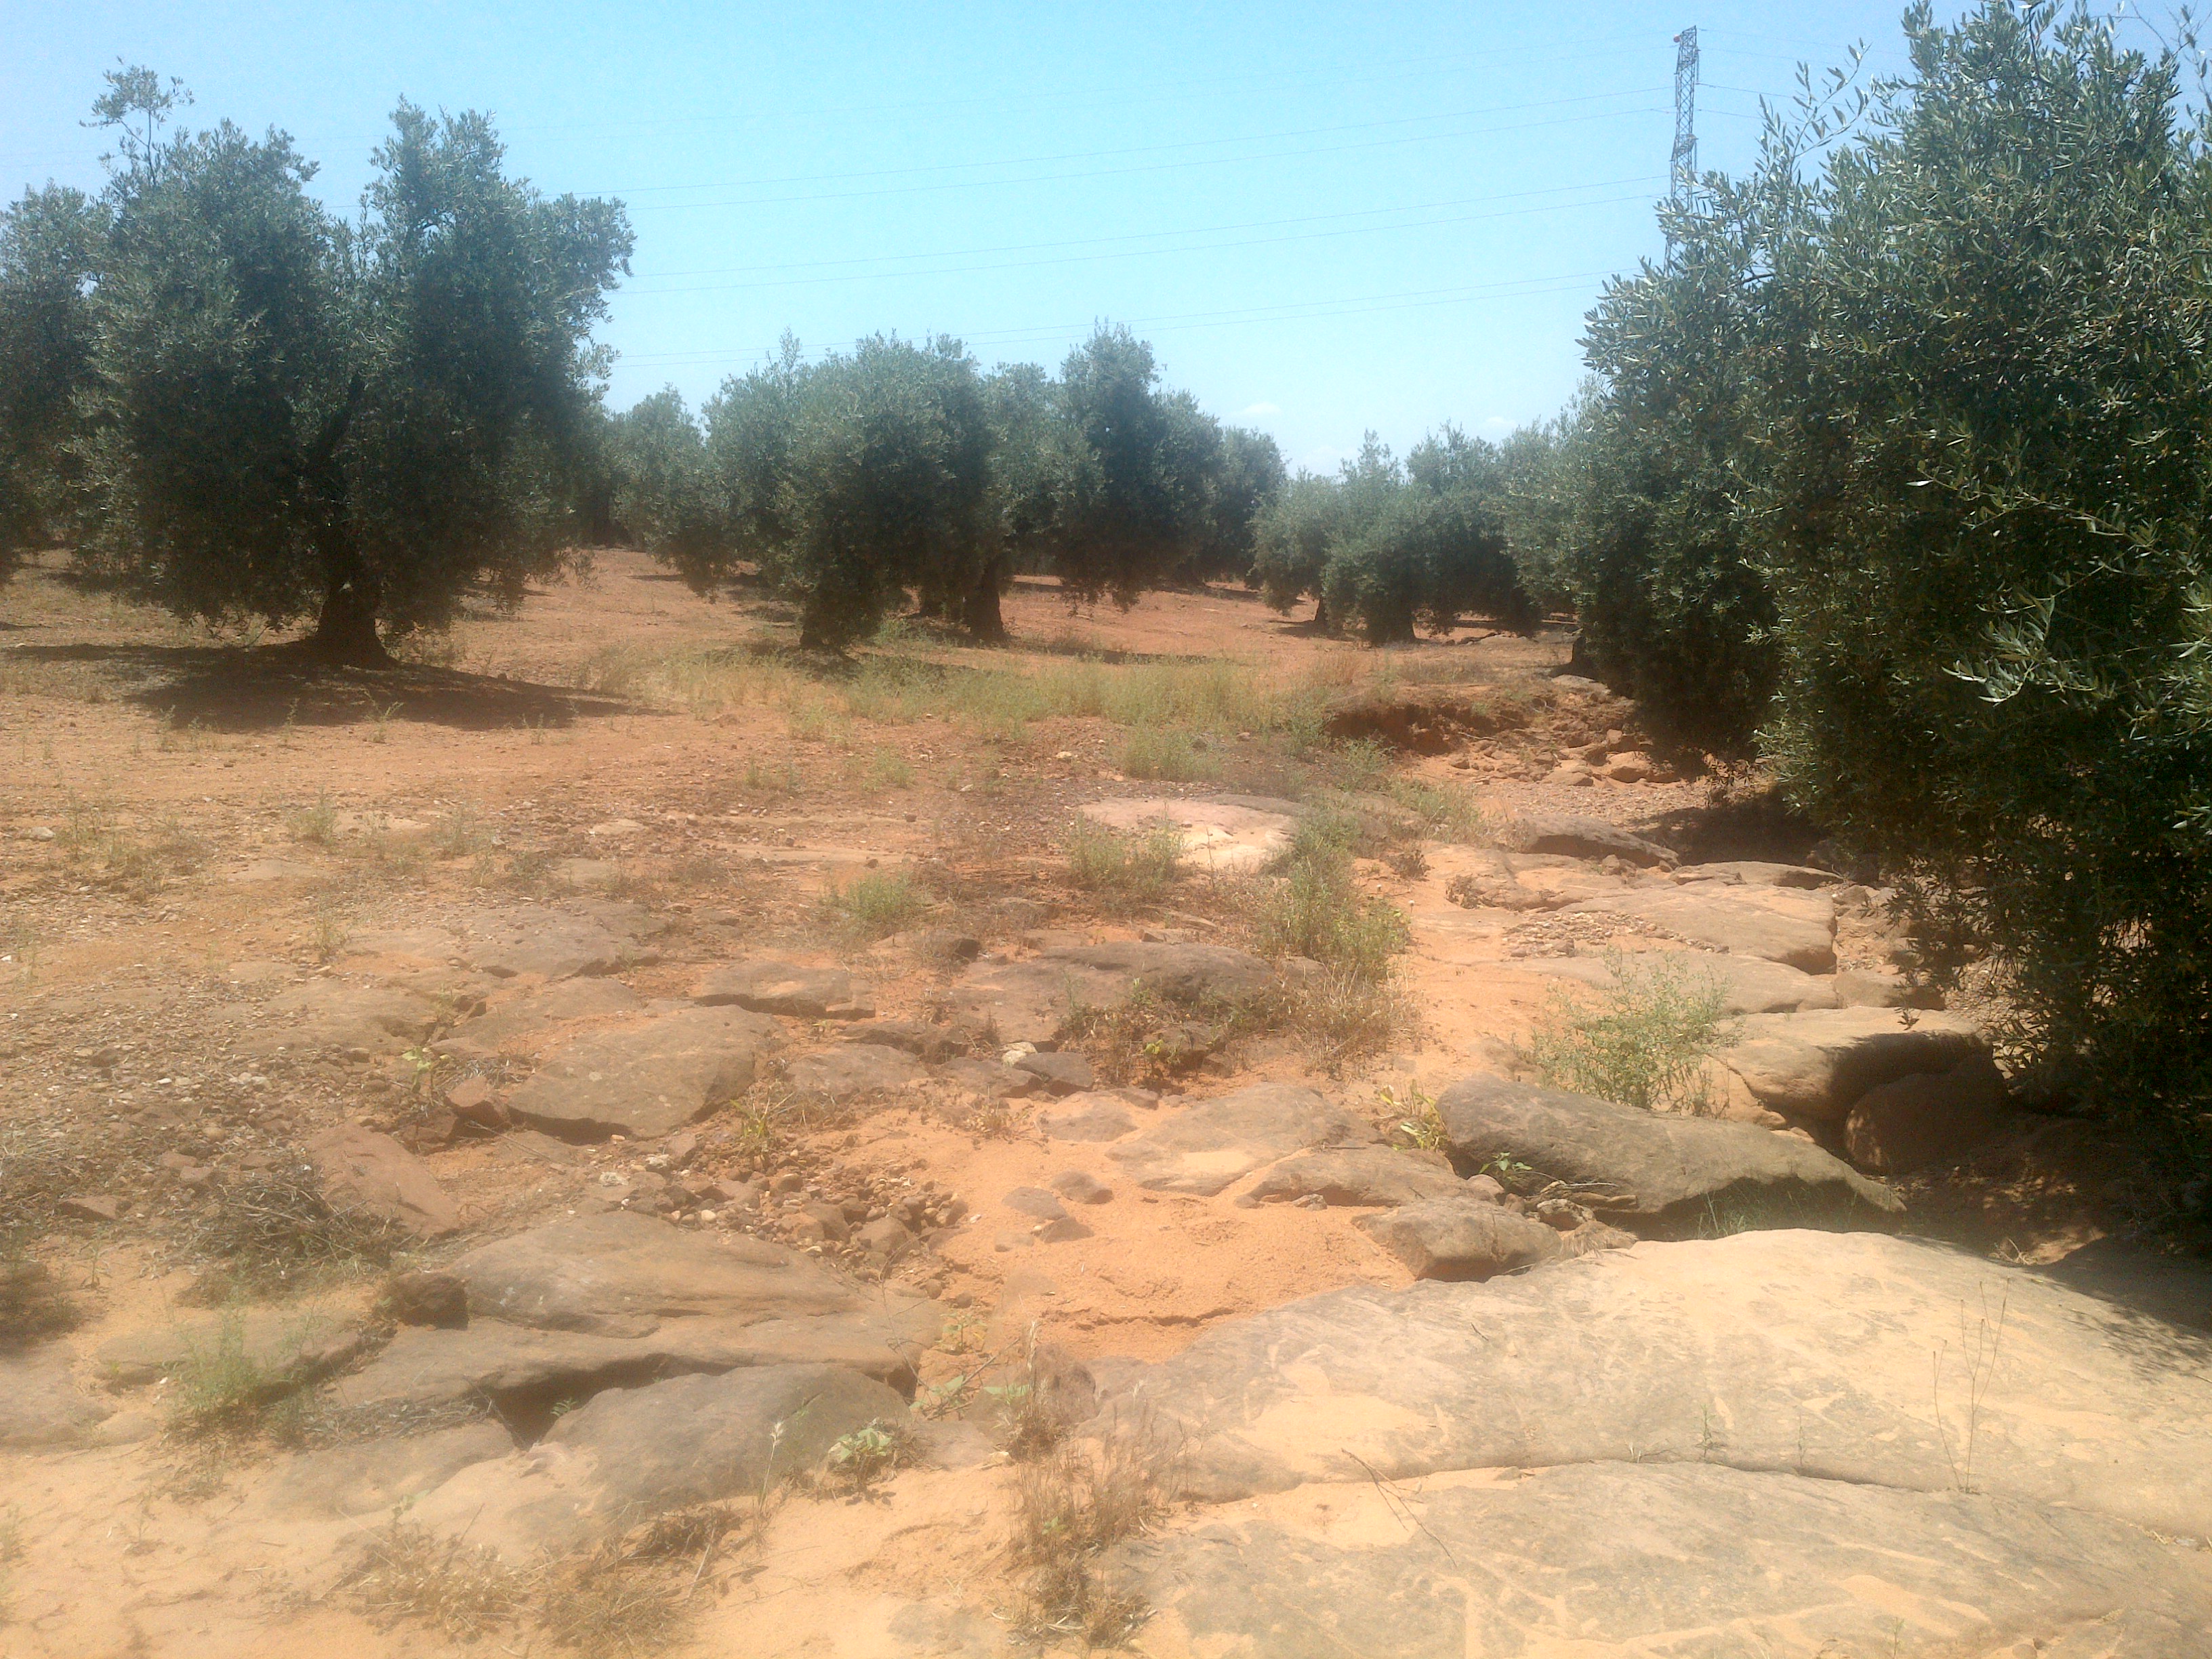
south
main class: Cropland
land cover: Olive groves
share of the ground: 50 - 75 %
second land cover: Spontaneously vegetated surfaces
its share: 10 - 25 %
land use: Agriculture (excluding fallow land and kitchen gardens)
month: June
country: ES
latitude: 38.0519
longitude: -4.3362
